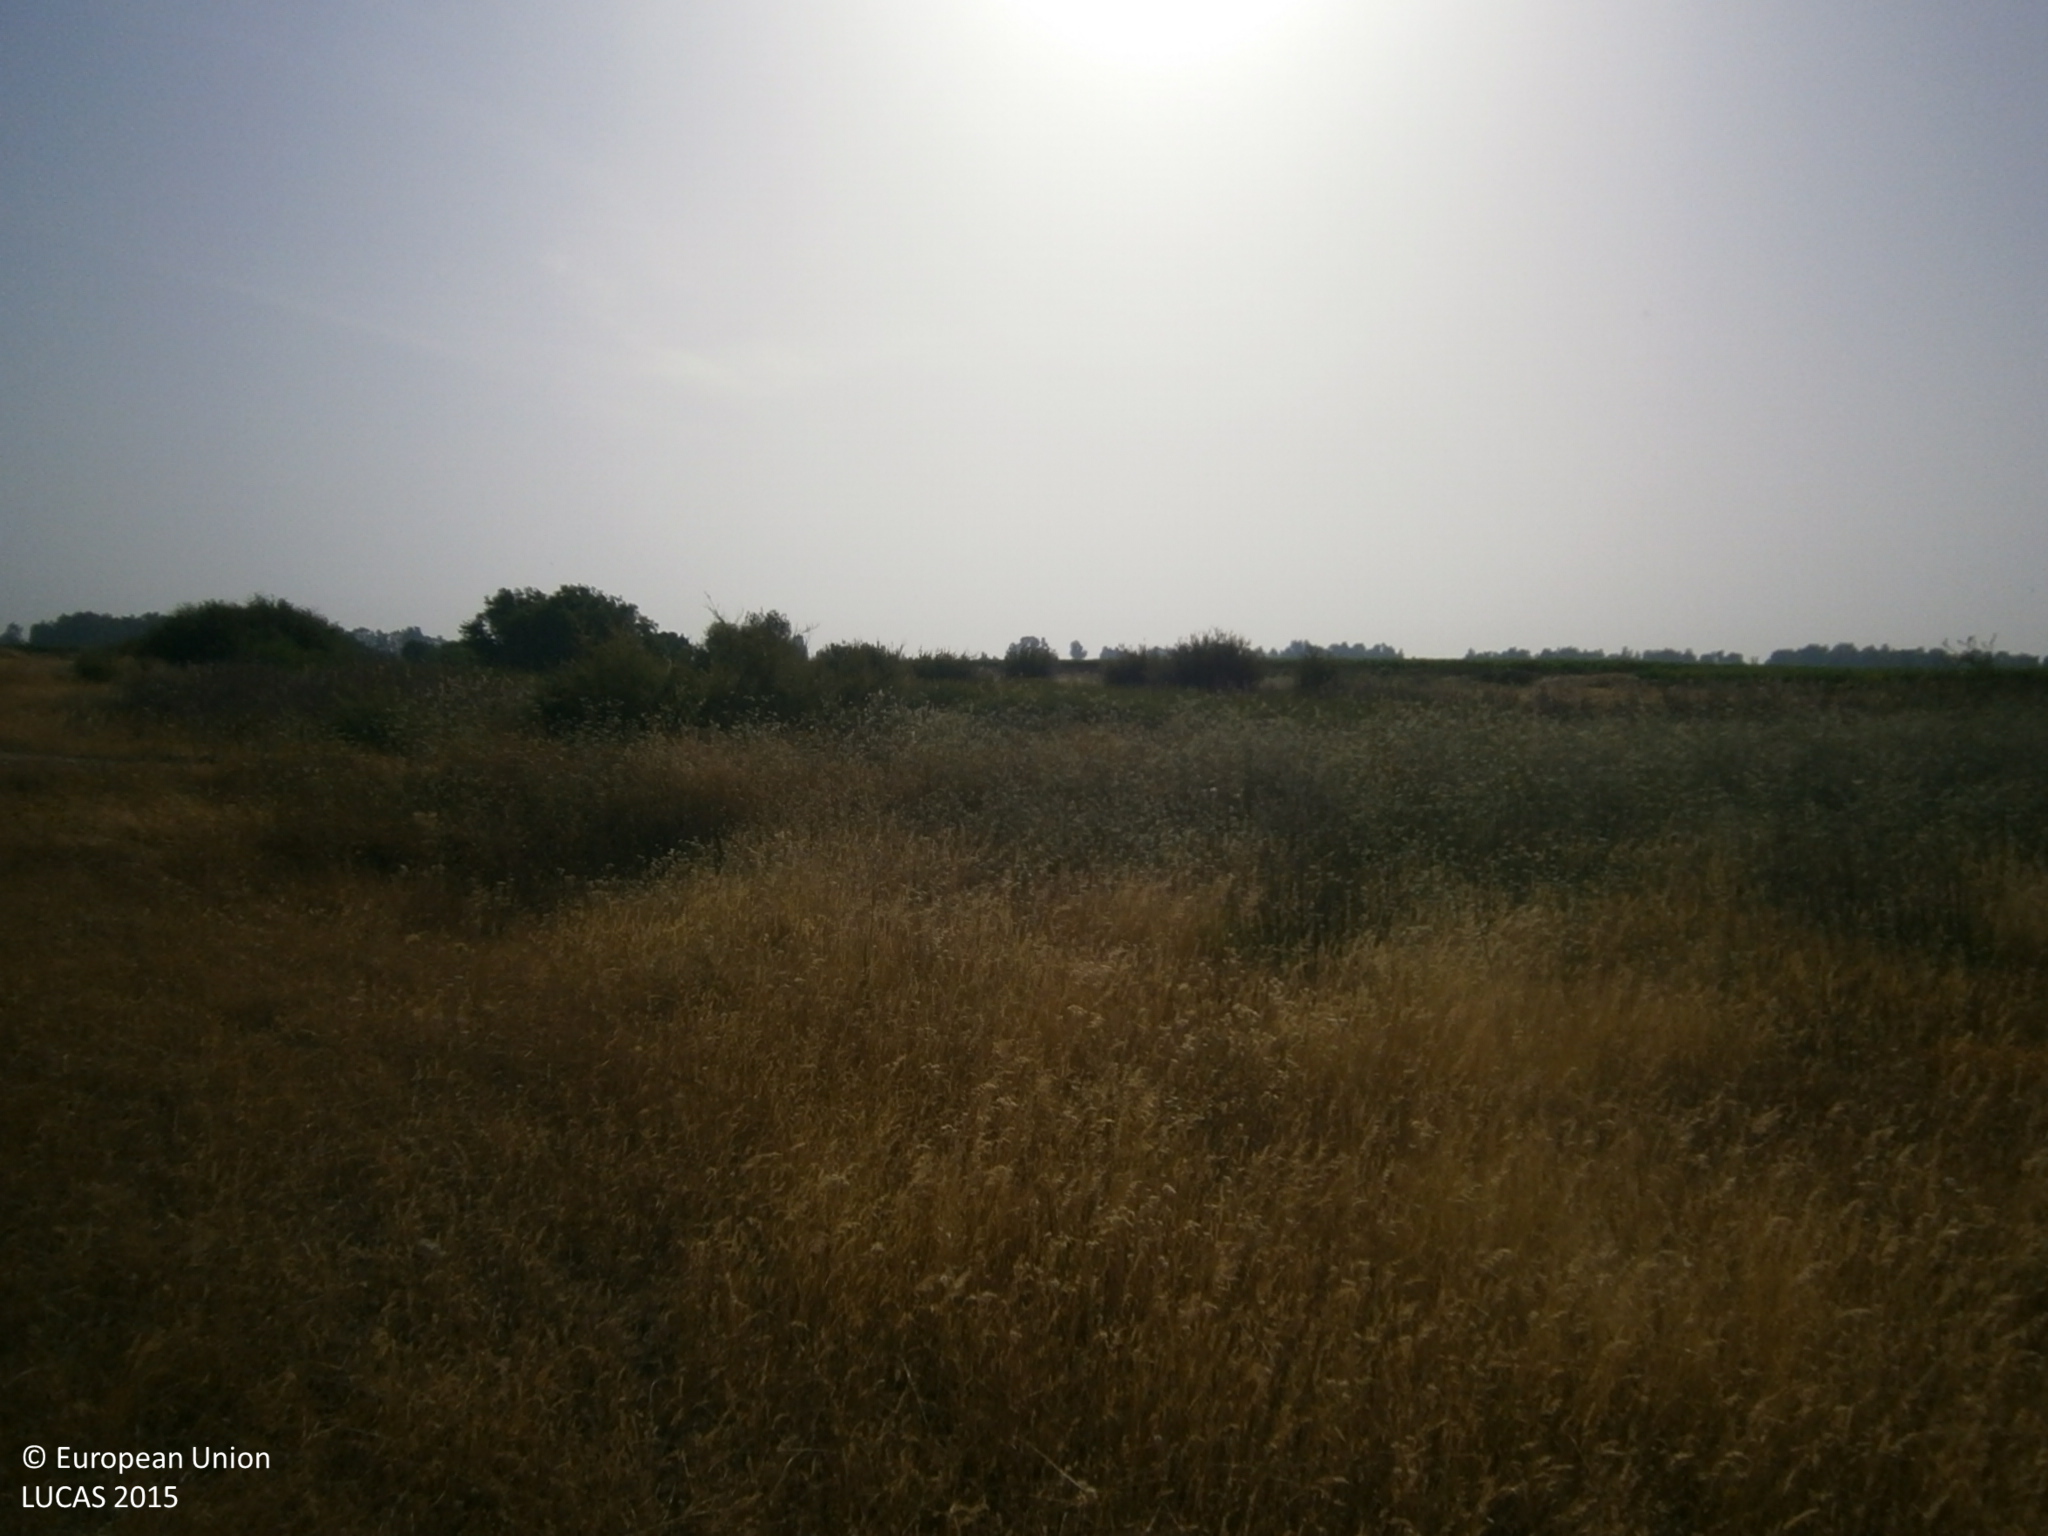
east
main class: Grassland
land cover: Grassland without tree/shrub cover
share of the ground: > 75 %
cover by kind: herbaceous plants 100 %
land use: Abandoned areas
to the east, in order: Grassland without tree/shrub cover; Tracks; Shruby margins; Ponds and wetlands; Shruby margins; Grassland without tree/shrub cover; Maize
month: June
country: ES
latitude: 38.8698
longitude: -6.2250
